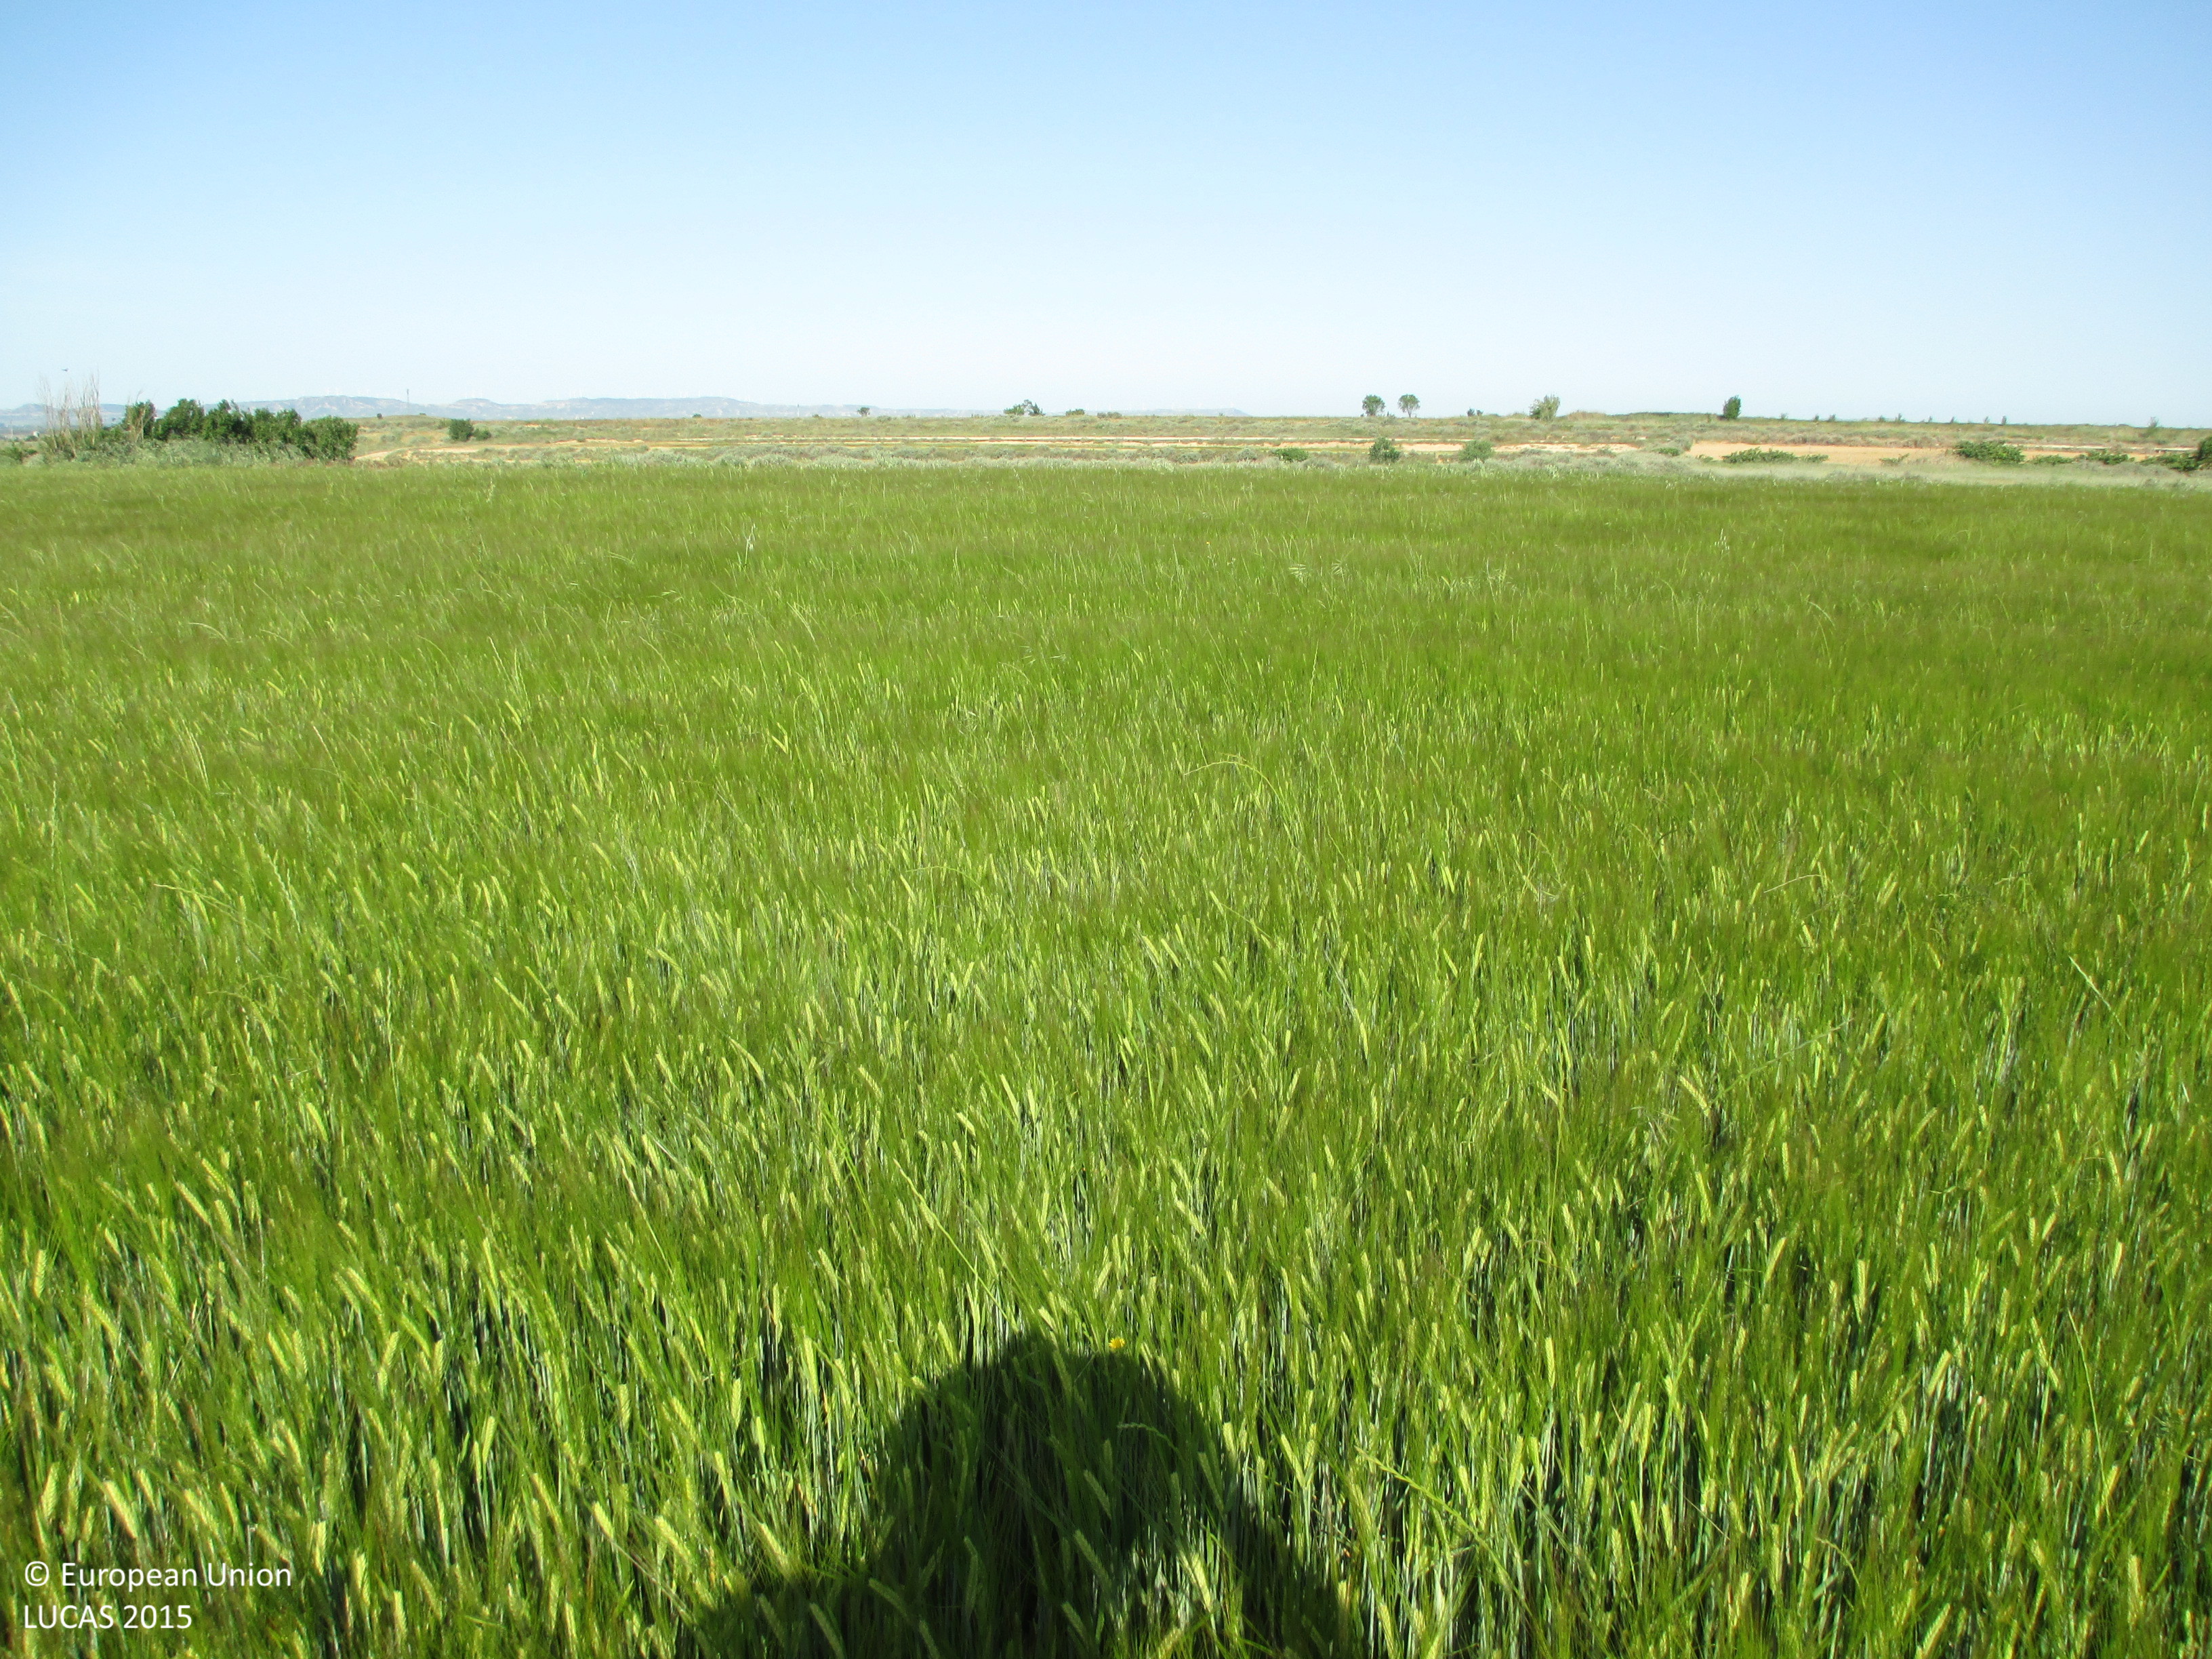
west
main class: Cropland
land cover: Barley
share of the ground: > 75 %
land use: Agriculture (excluding fallow land and kitchen gardens)
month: May
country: ES
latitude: 41.9576
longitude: -0.3602
